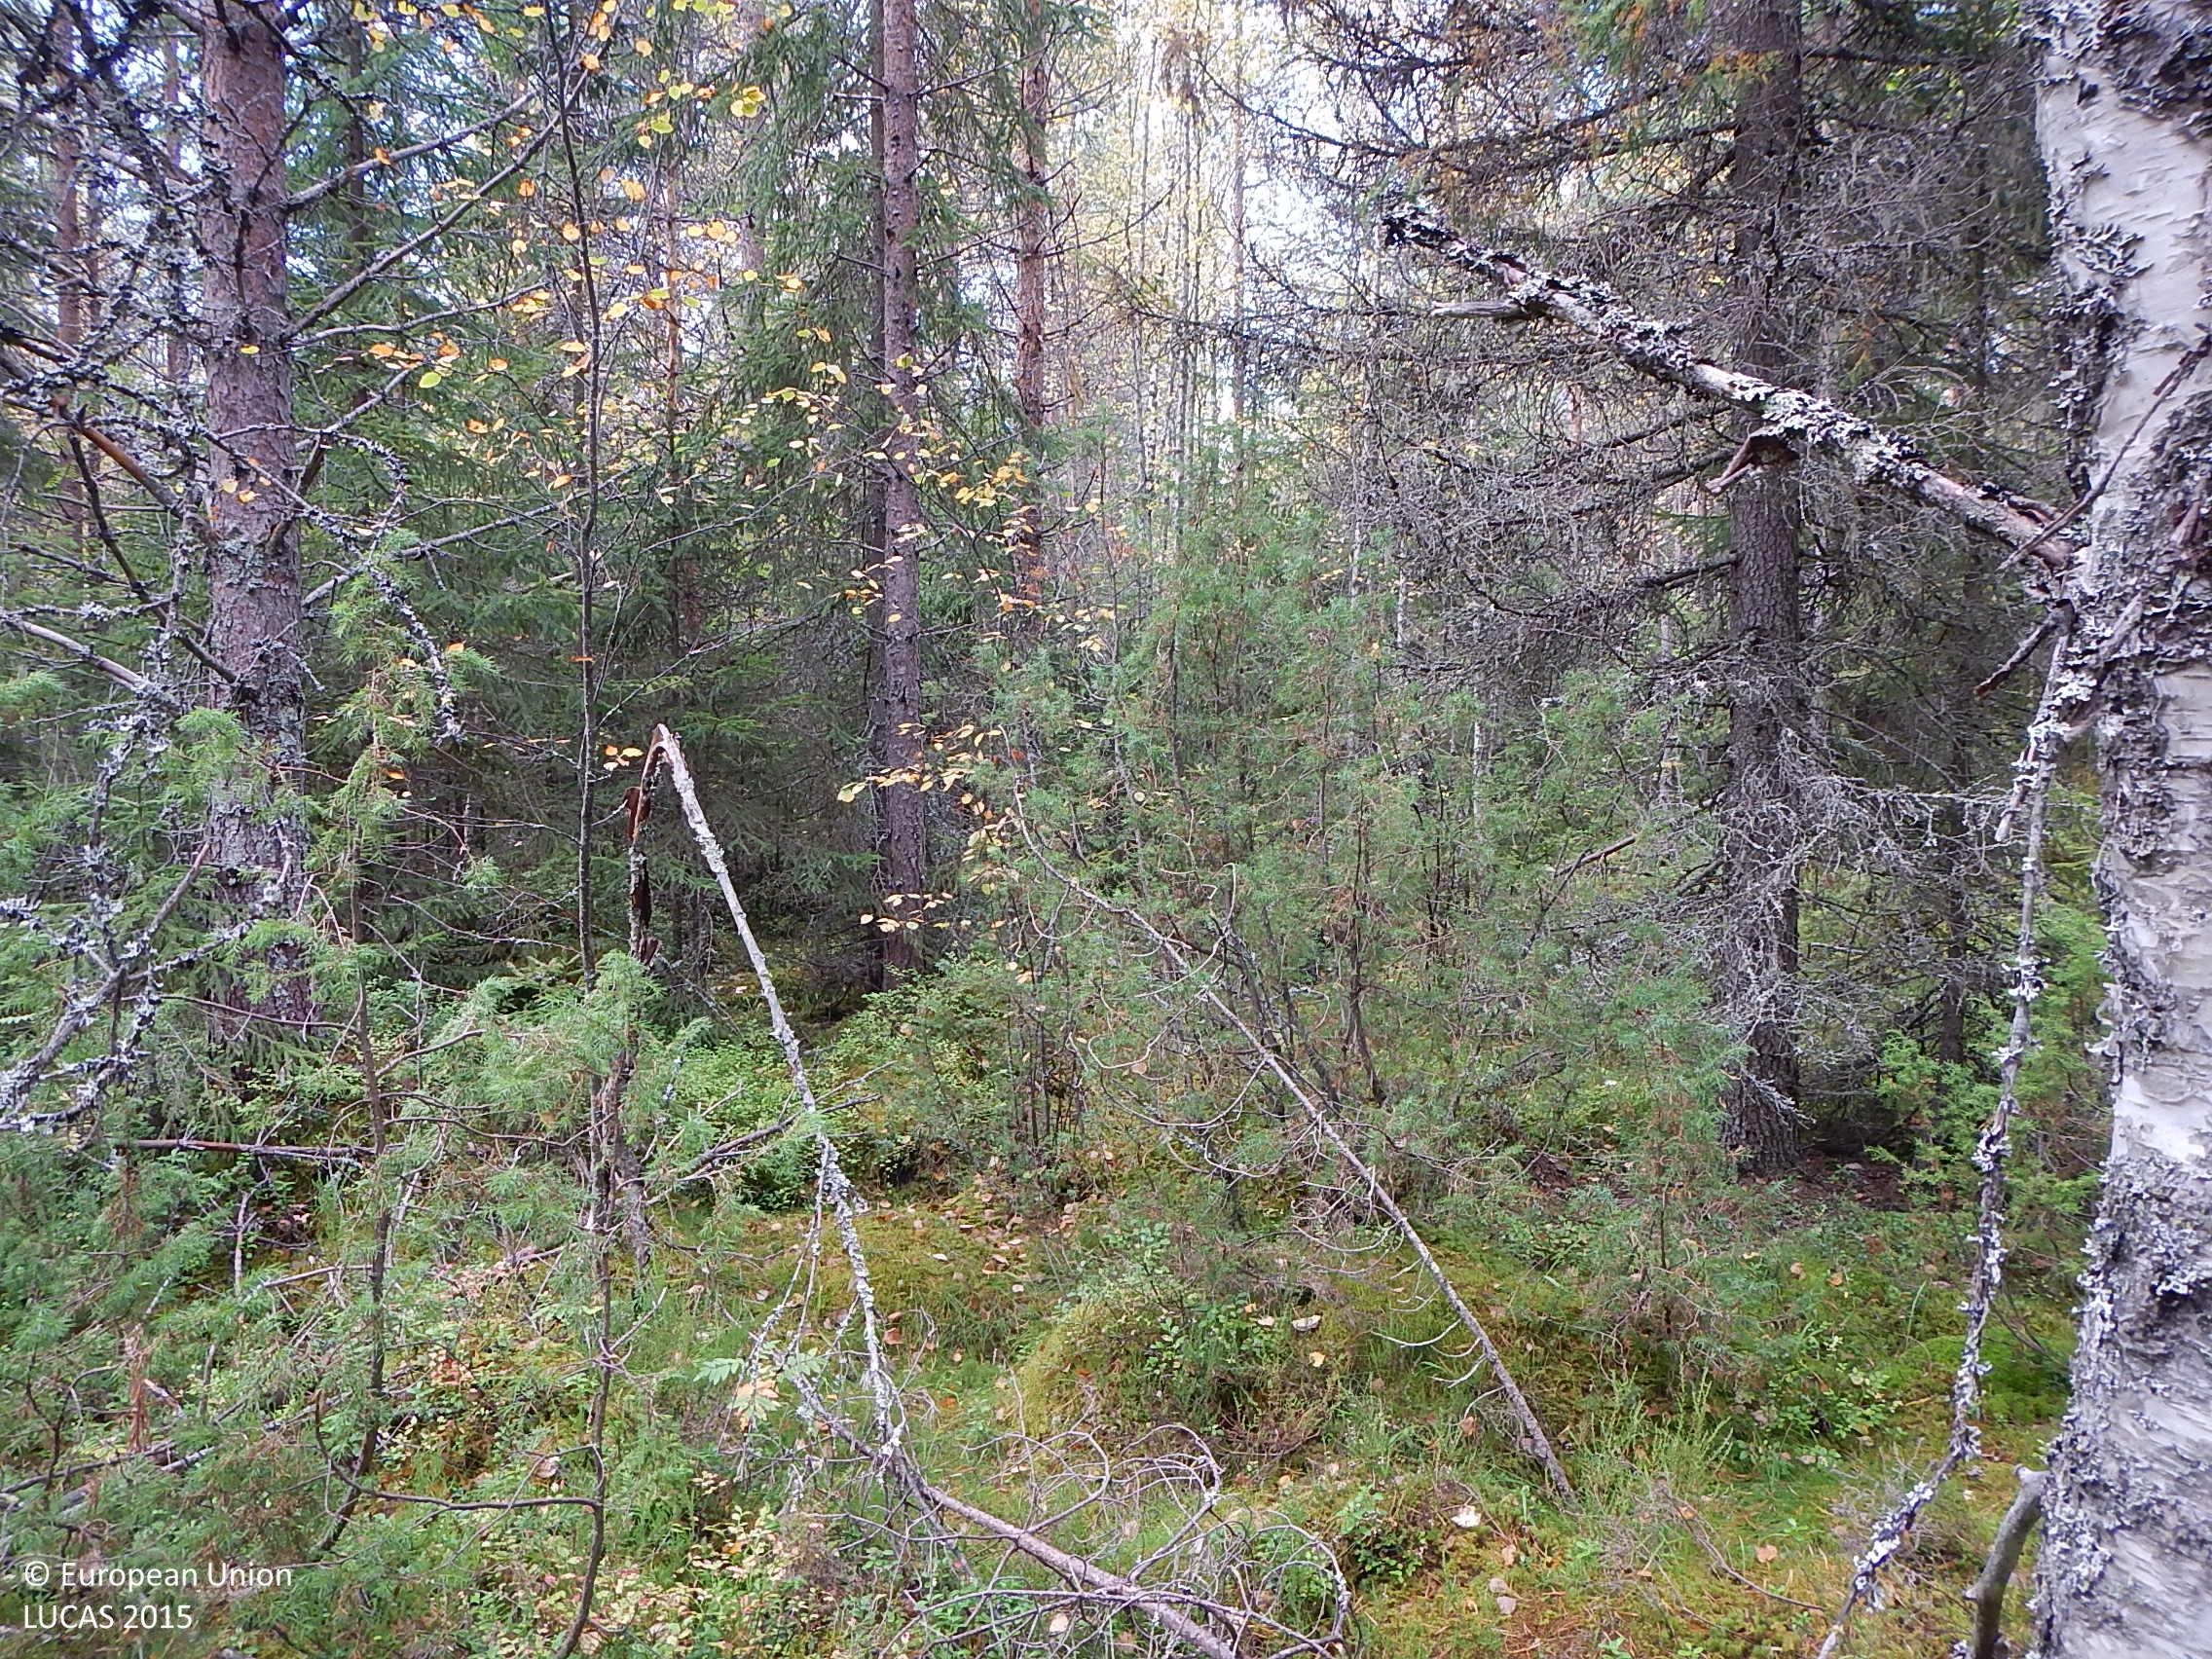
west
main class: Woodland
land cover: Other mixed woodland
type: boreal forest
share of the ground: 50 - 75 %
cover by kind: coniferous forest trees 40 %, broadleaved forest trees 25 %, shrubs 20 %, lichens and mosses 10 %, herbaceous plants 5 %
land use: Forestry
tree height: > 5 m
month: September
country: FI
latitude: 62.0016
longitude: 22.8778
